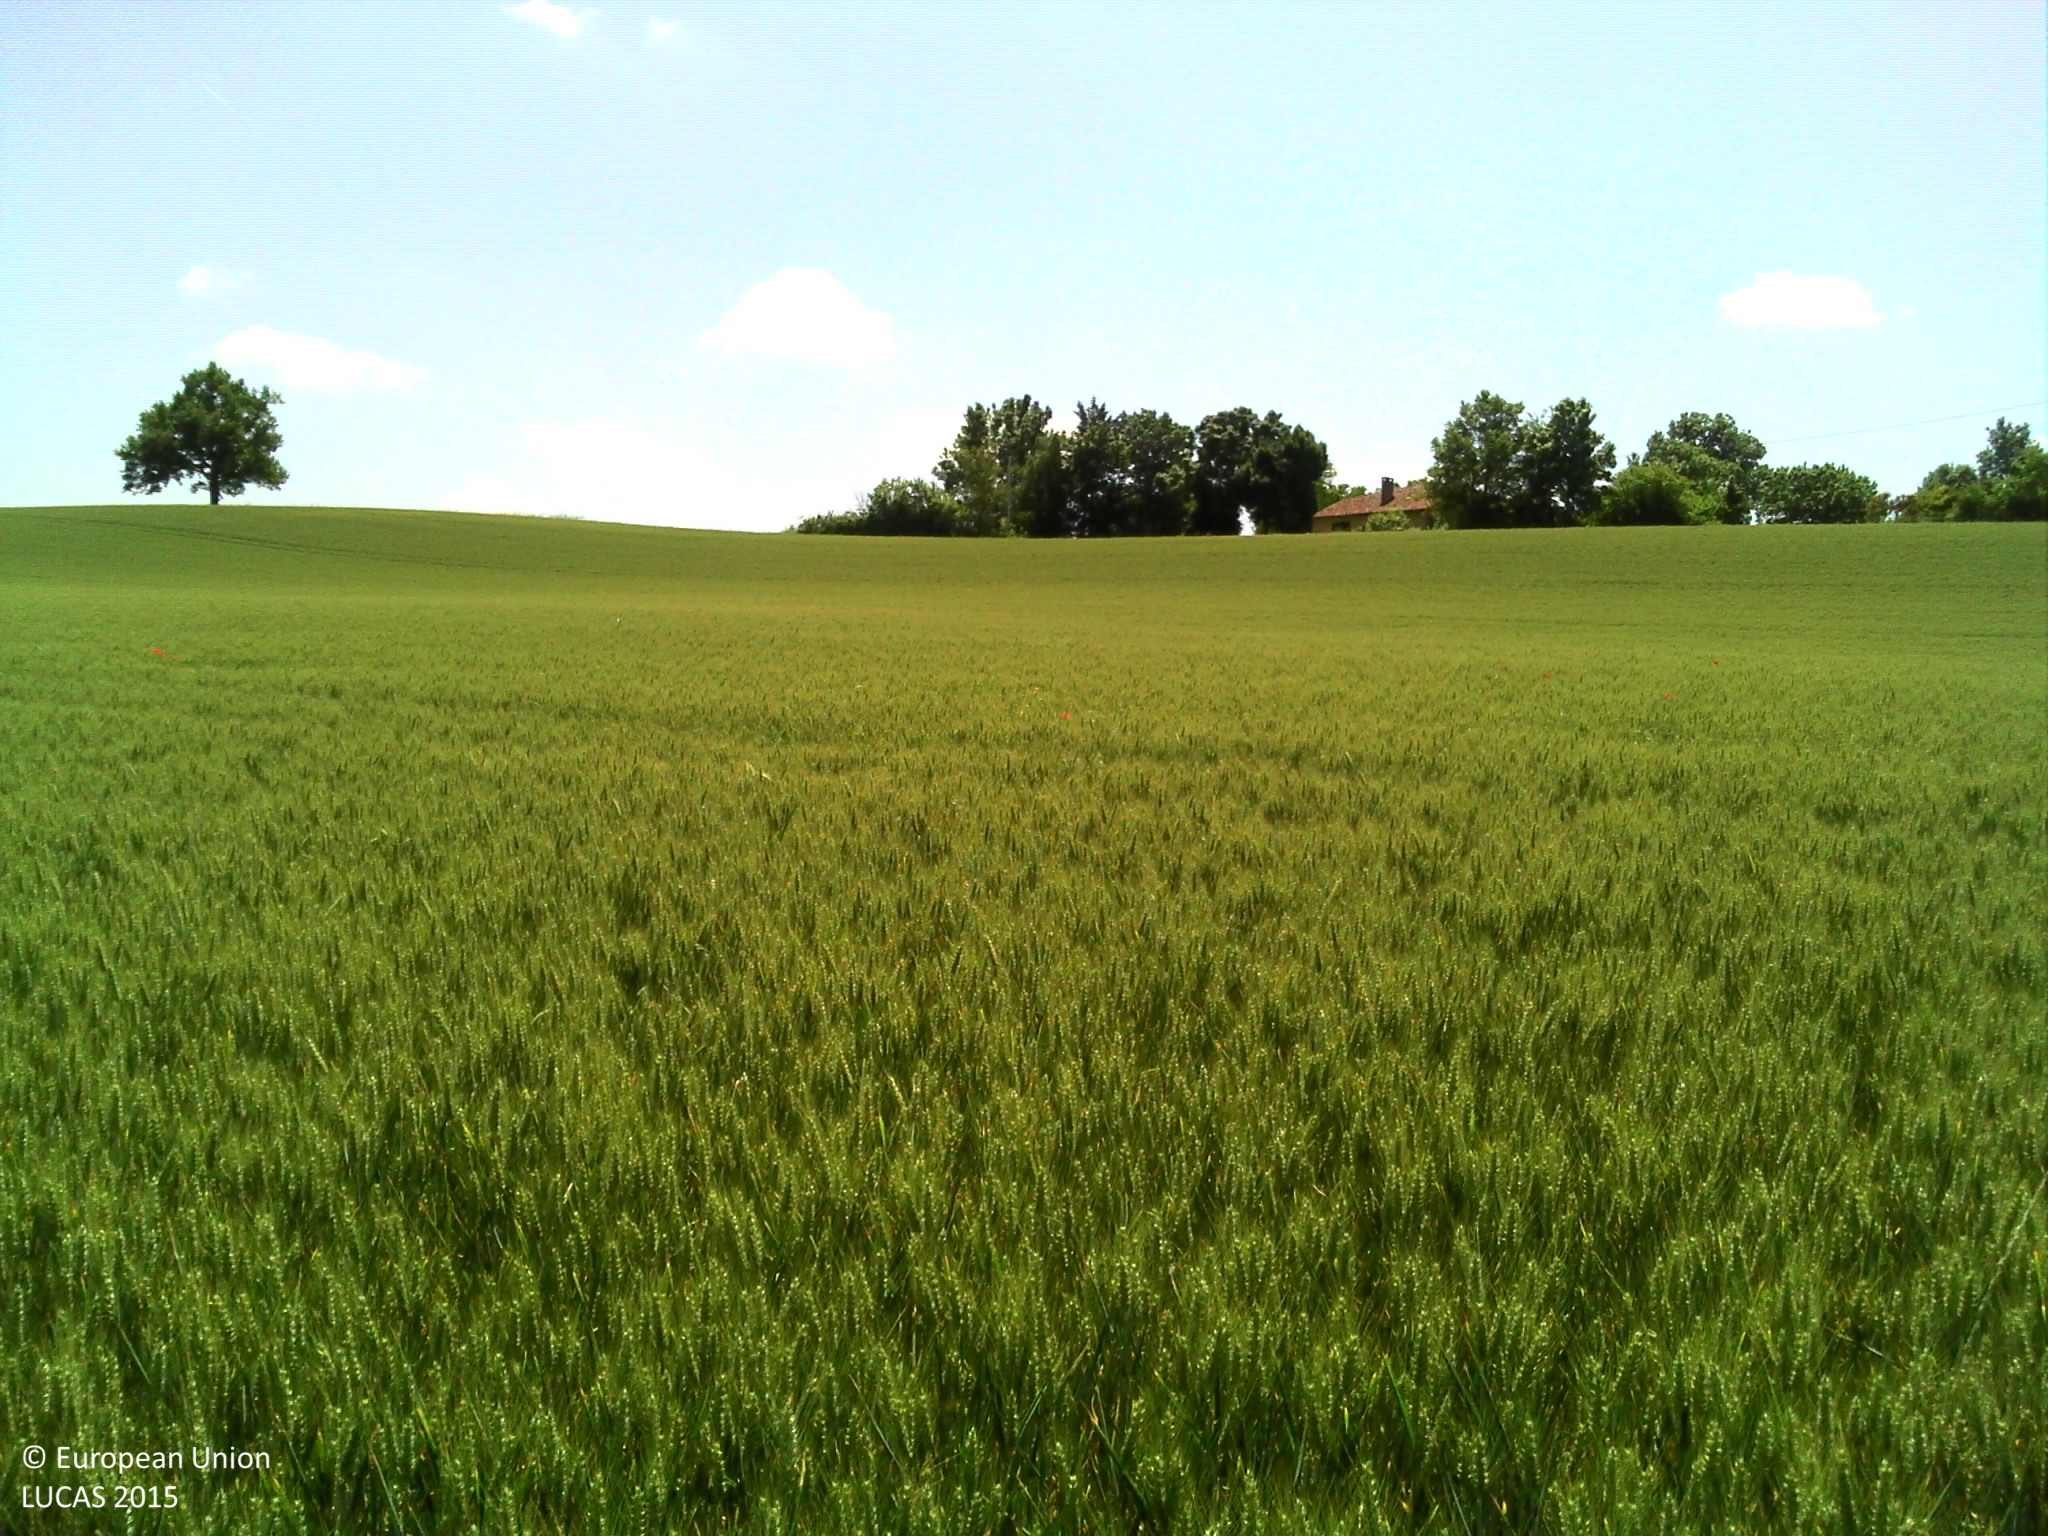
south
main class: Cropland
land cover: Common wheat
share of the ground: > 75 %
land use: Agriculture (excluding fallow land and kitchen gardens)
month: June
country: FR
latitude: 43.5937
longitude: 0.7711
